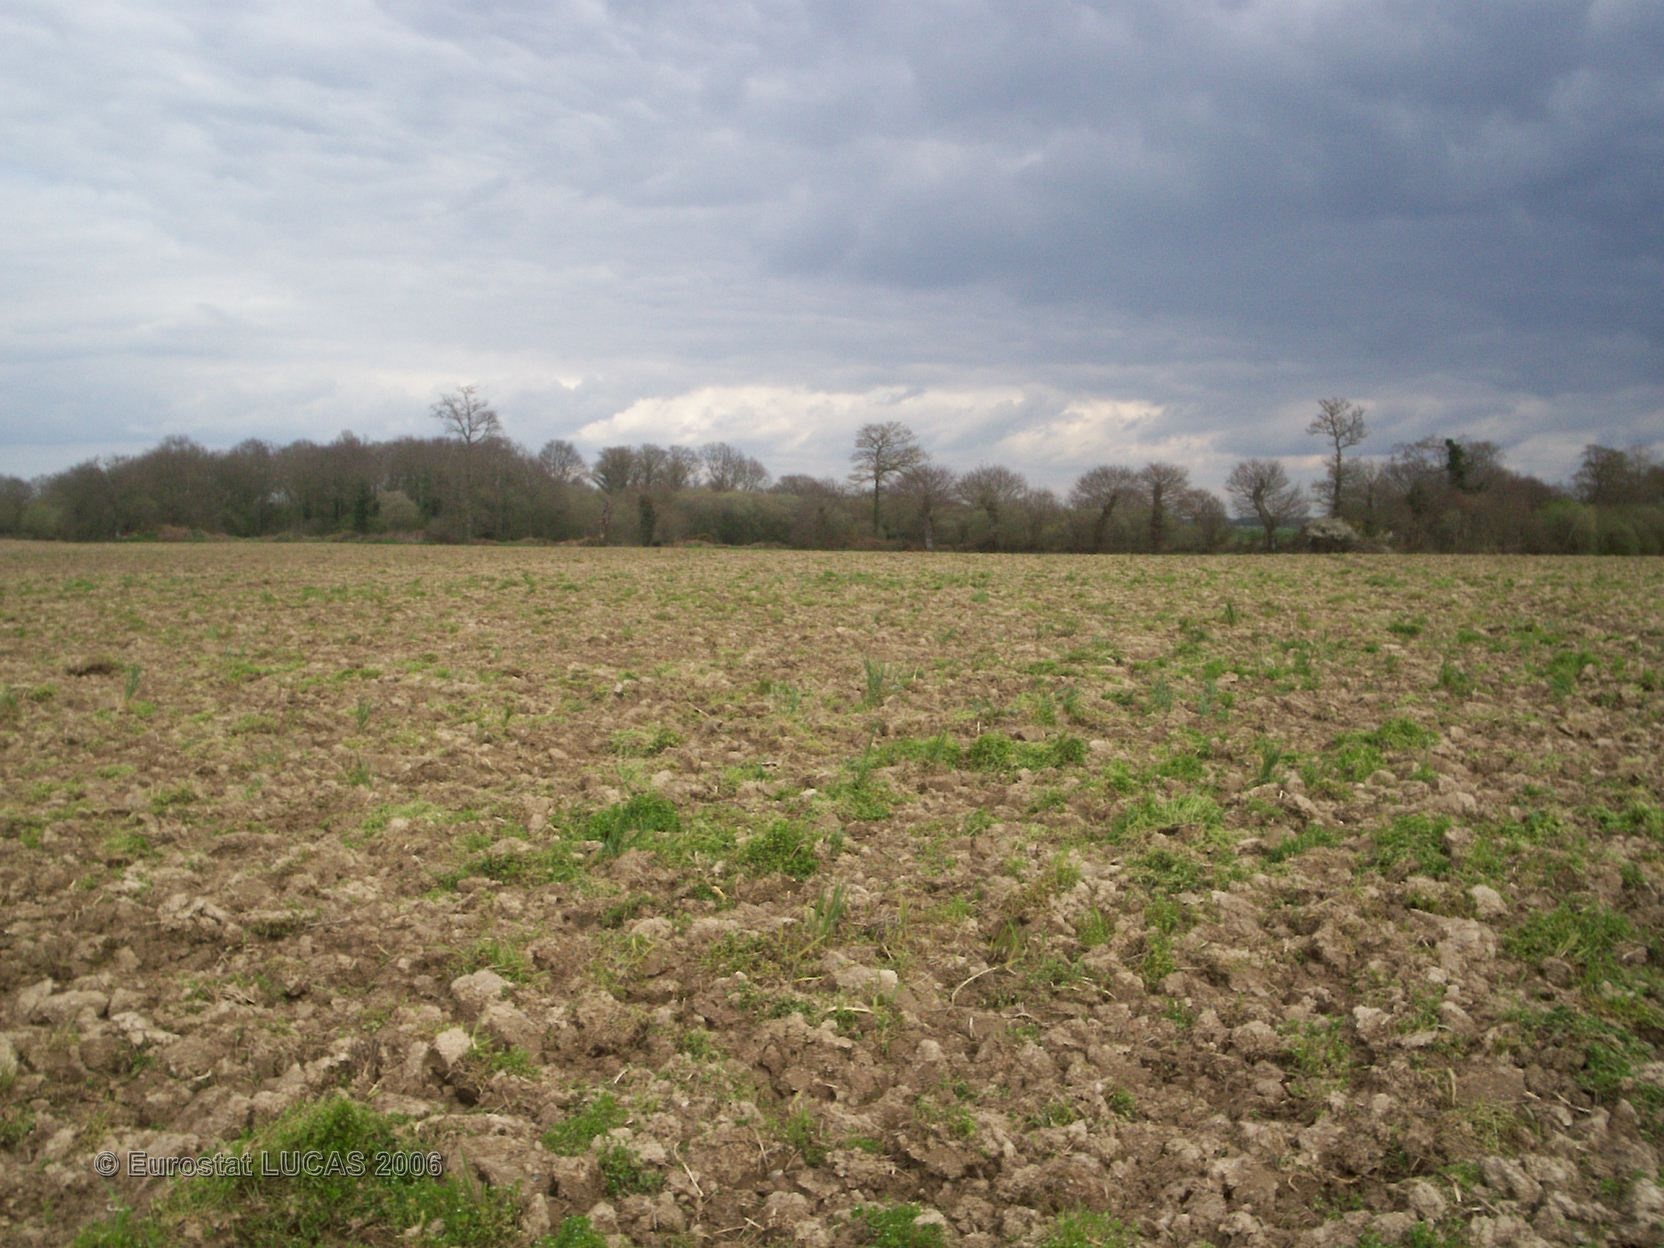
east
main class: Cropland
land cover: Maize
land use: Agriculture (excluding fallow land and kitchen gardens)
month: June
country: FR
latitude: 48.4892
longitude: -2.5239
